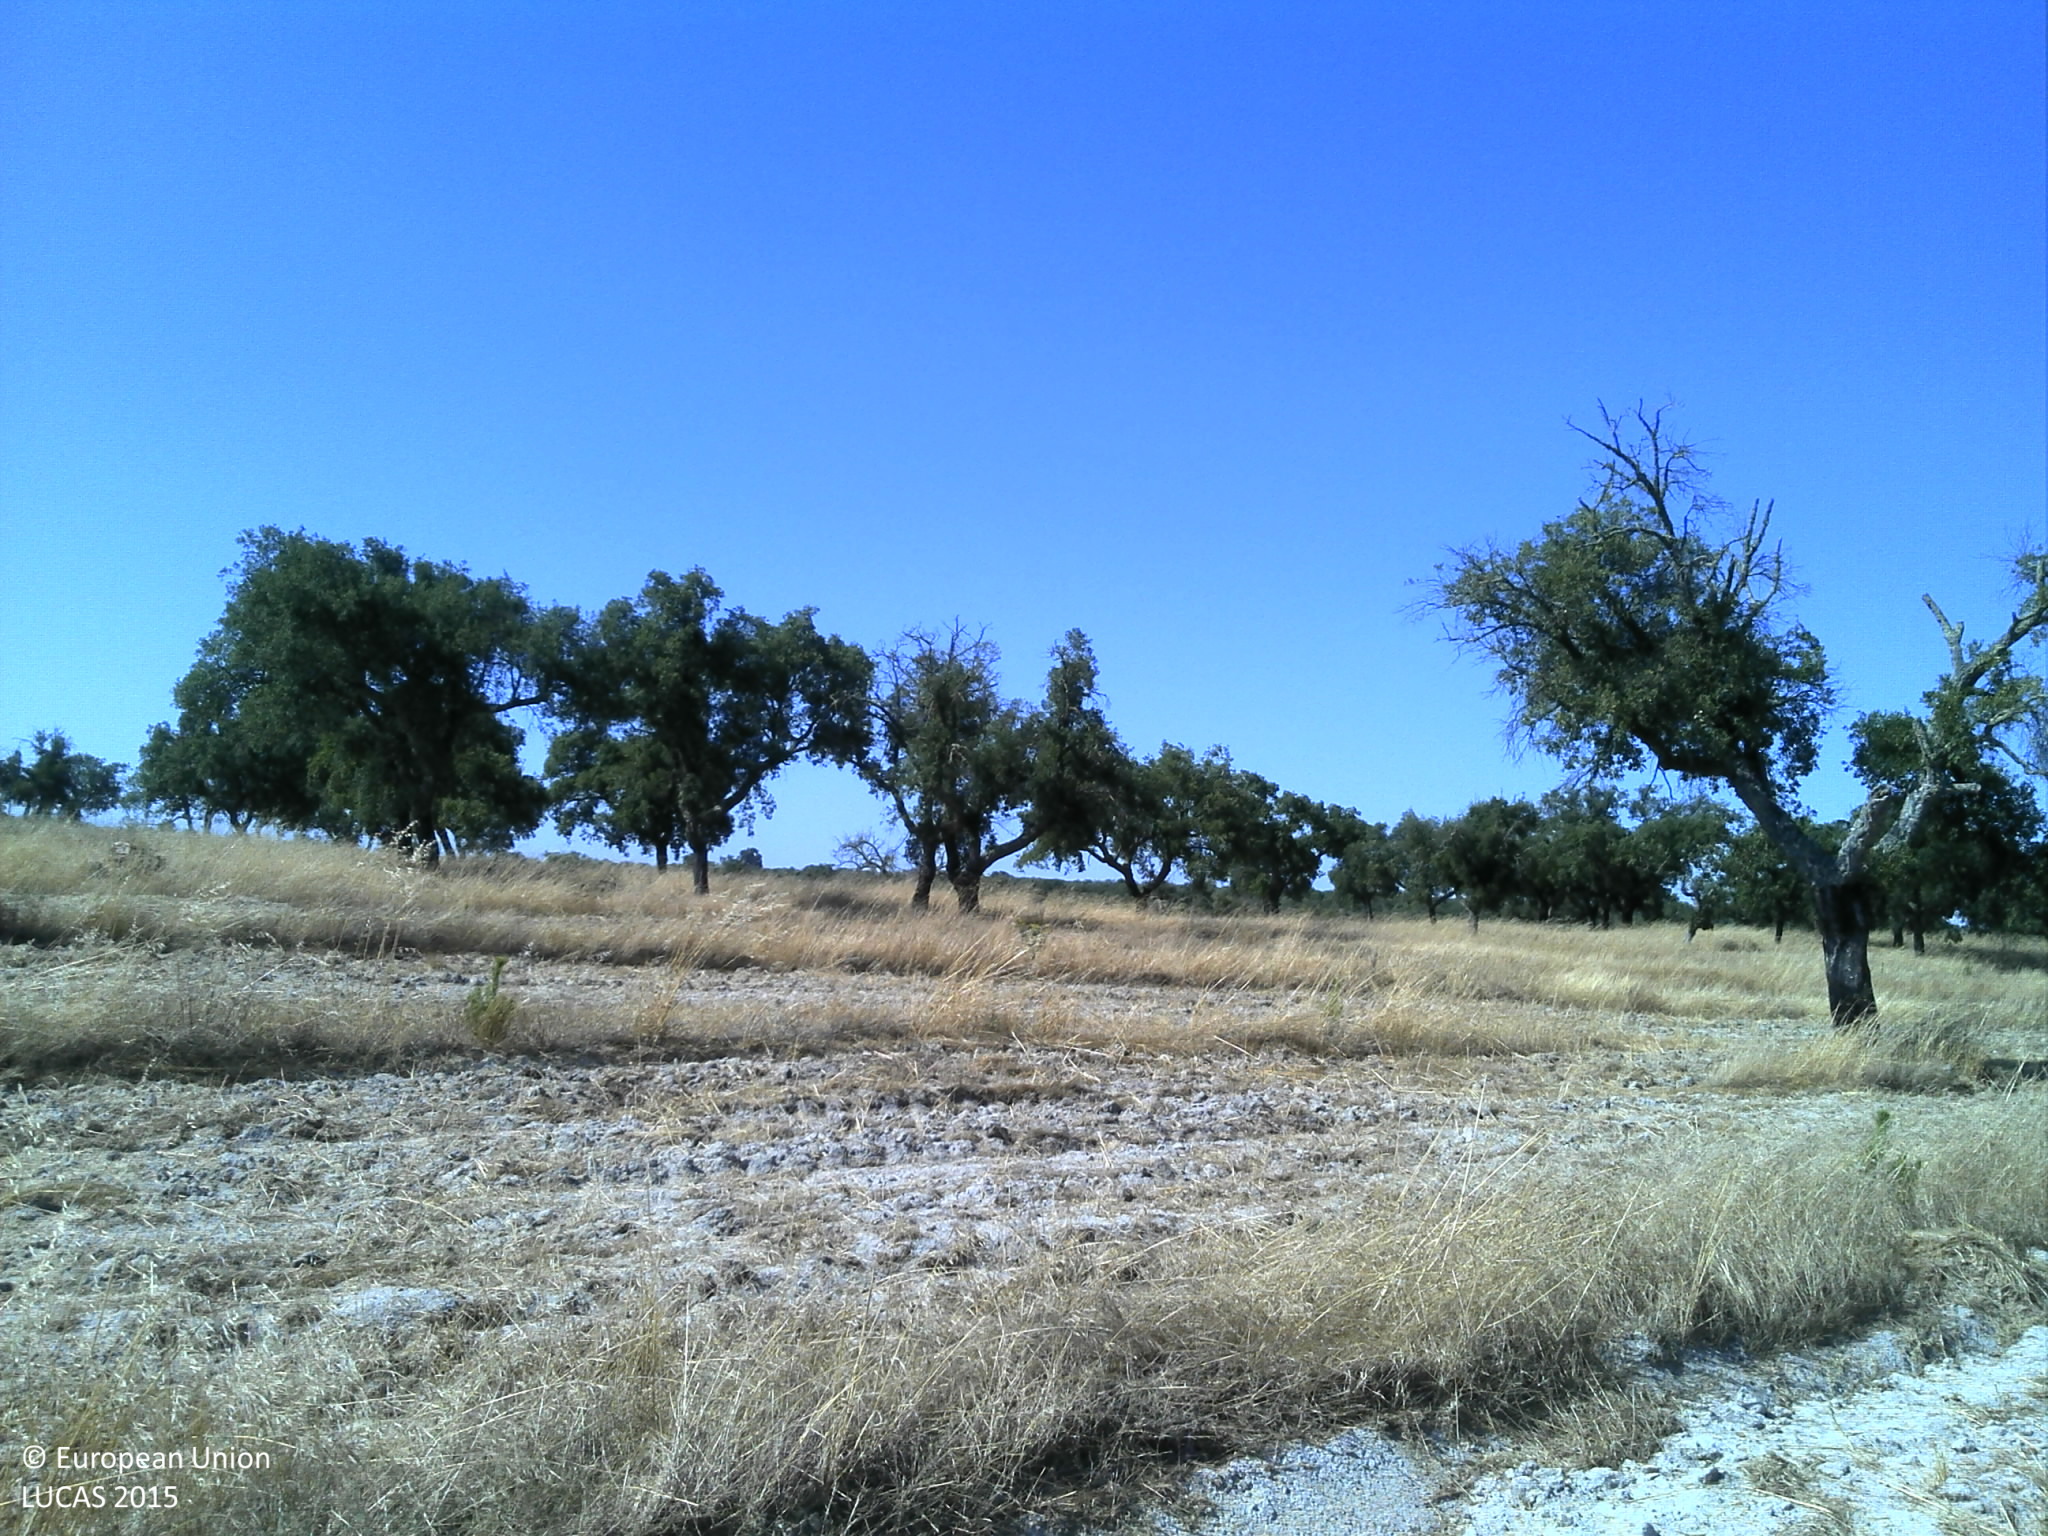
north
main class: Grassland
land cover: Grassland with sparse tree/shrub cover
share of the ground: 10 - 25 %
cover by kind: unconsolidated bare surface 80 %, herbaceous plants 15 %, broadleaved forest trees 5 %
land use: Forestry
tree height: < 5 m
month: July
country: PT
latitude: 39.3190
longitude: -7.6426
